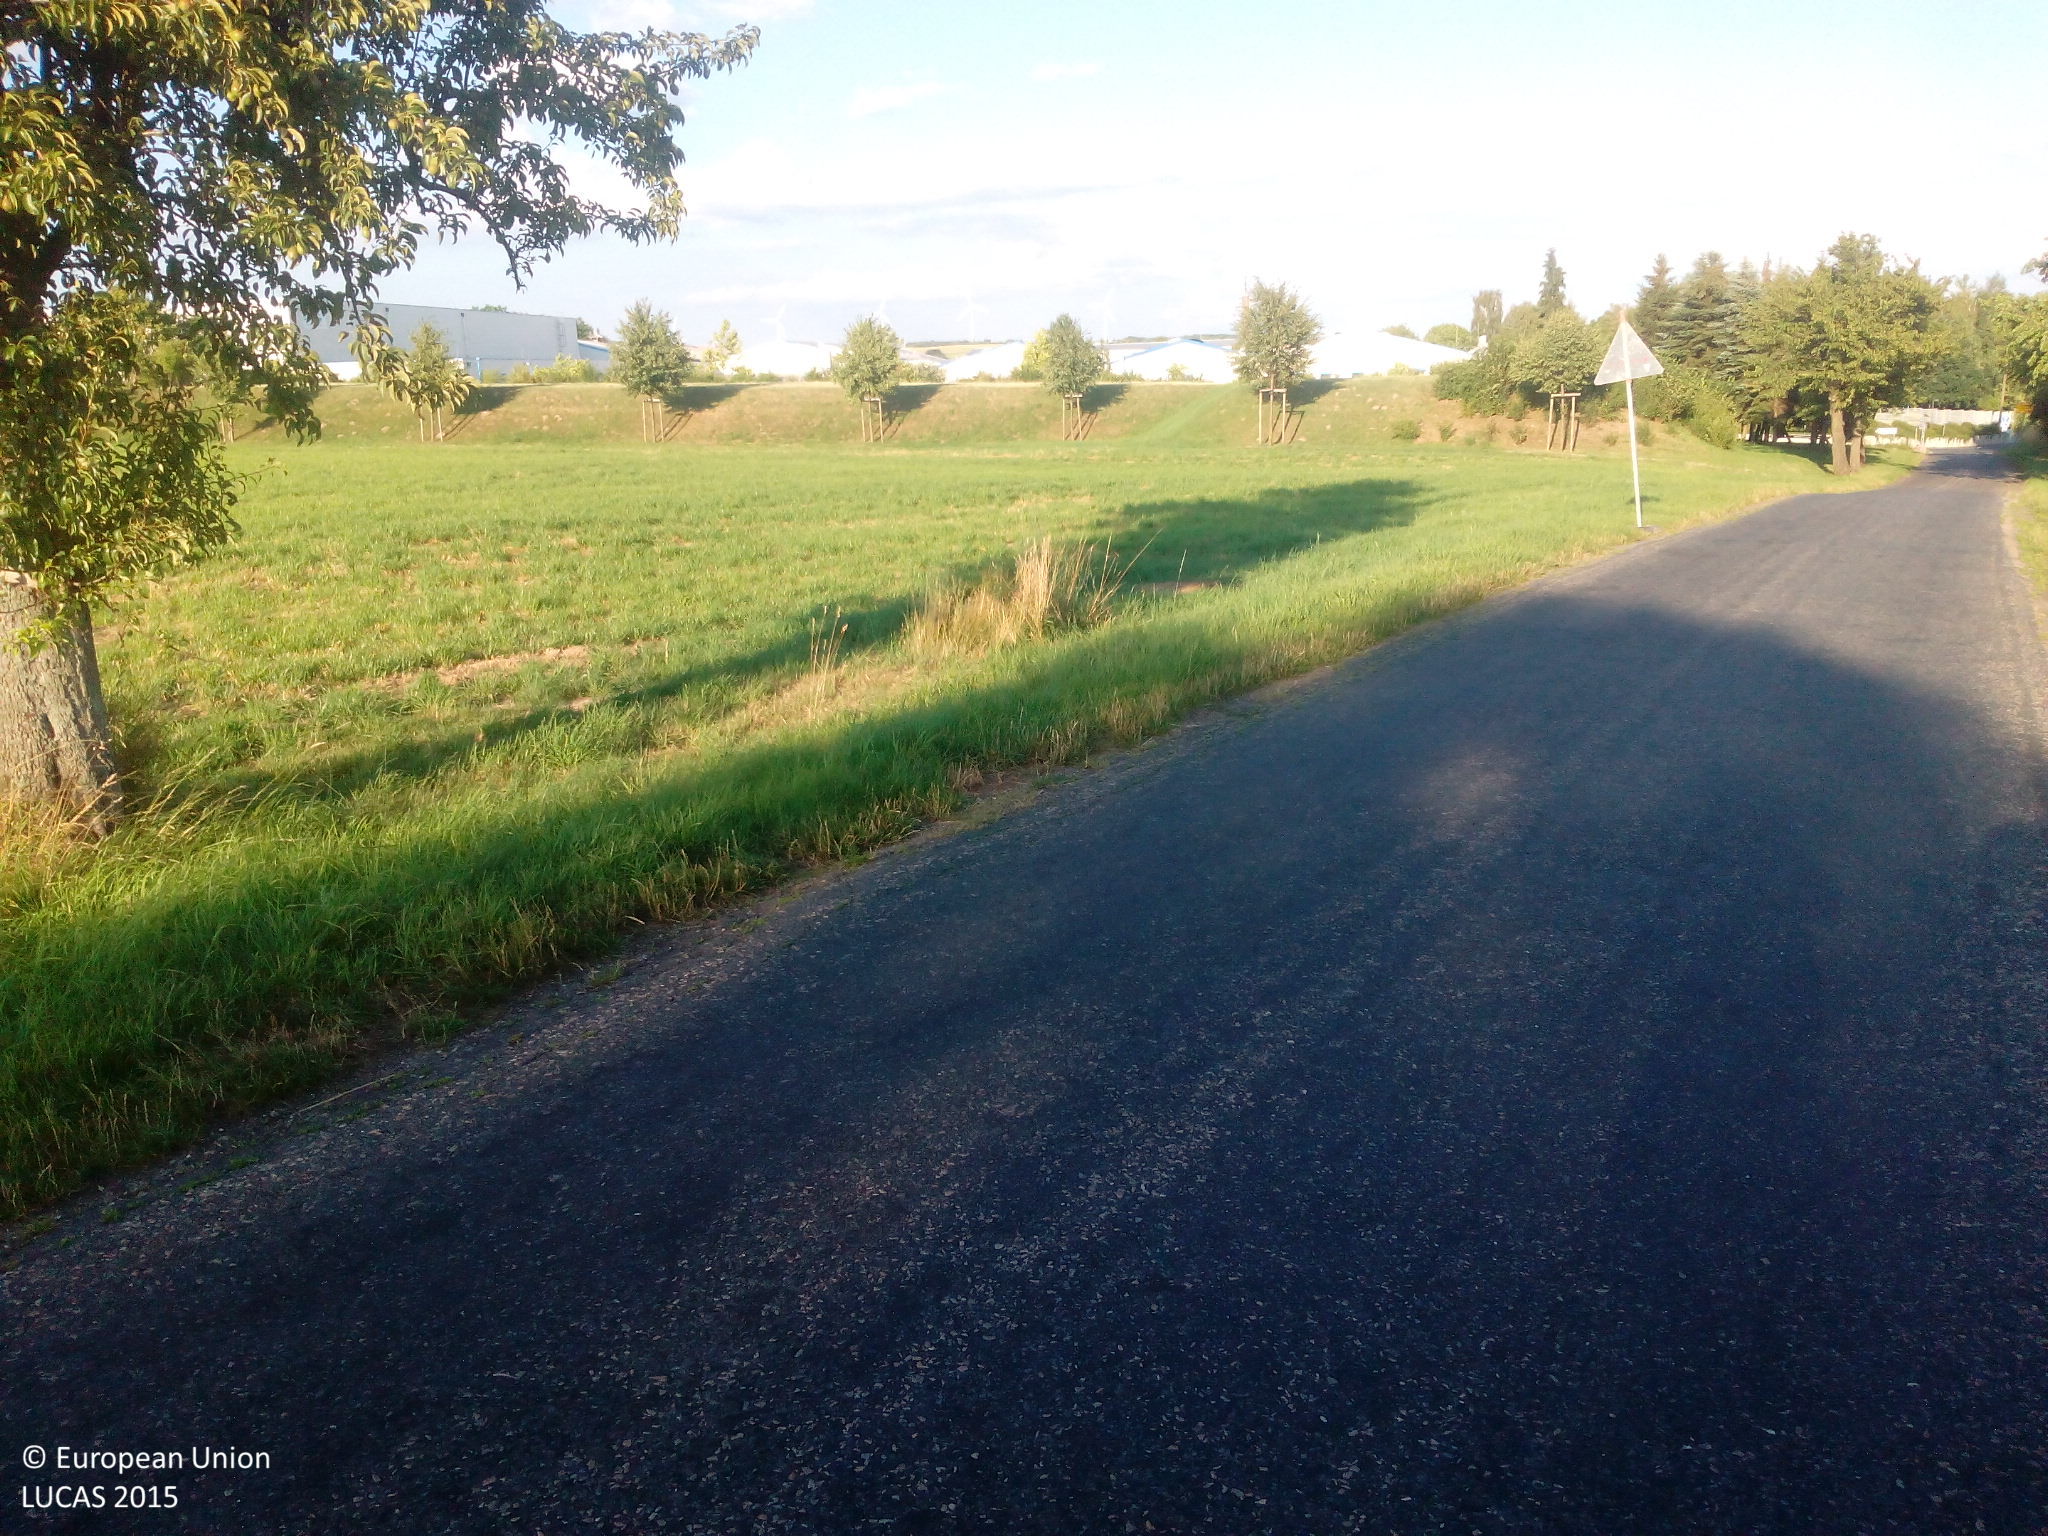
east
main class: Cropland
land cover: Rape and turnip rape
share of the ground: > 75 %
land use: Agriculture (excluding fallow land and kitchen gardens)
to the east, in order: Rape and turnip rape; Grass margins; Fences; Broadleaved woodland; Artificial constructions in urban areas
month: July
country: DE
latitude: 51.0690
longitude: 13.4111
